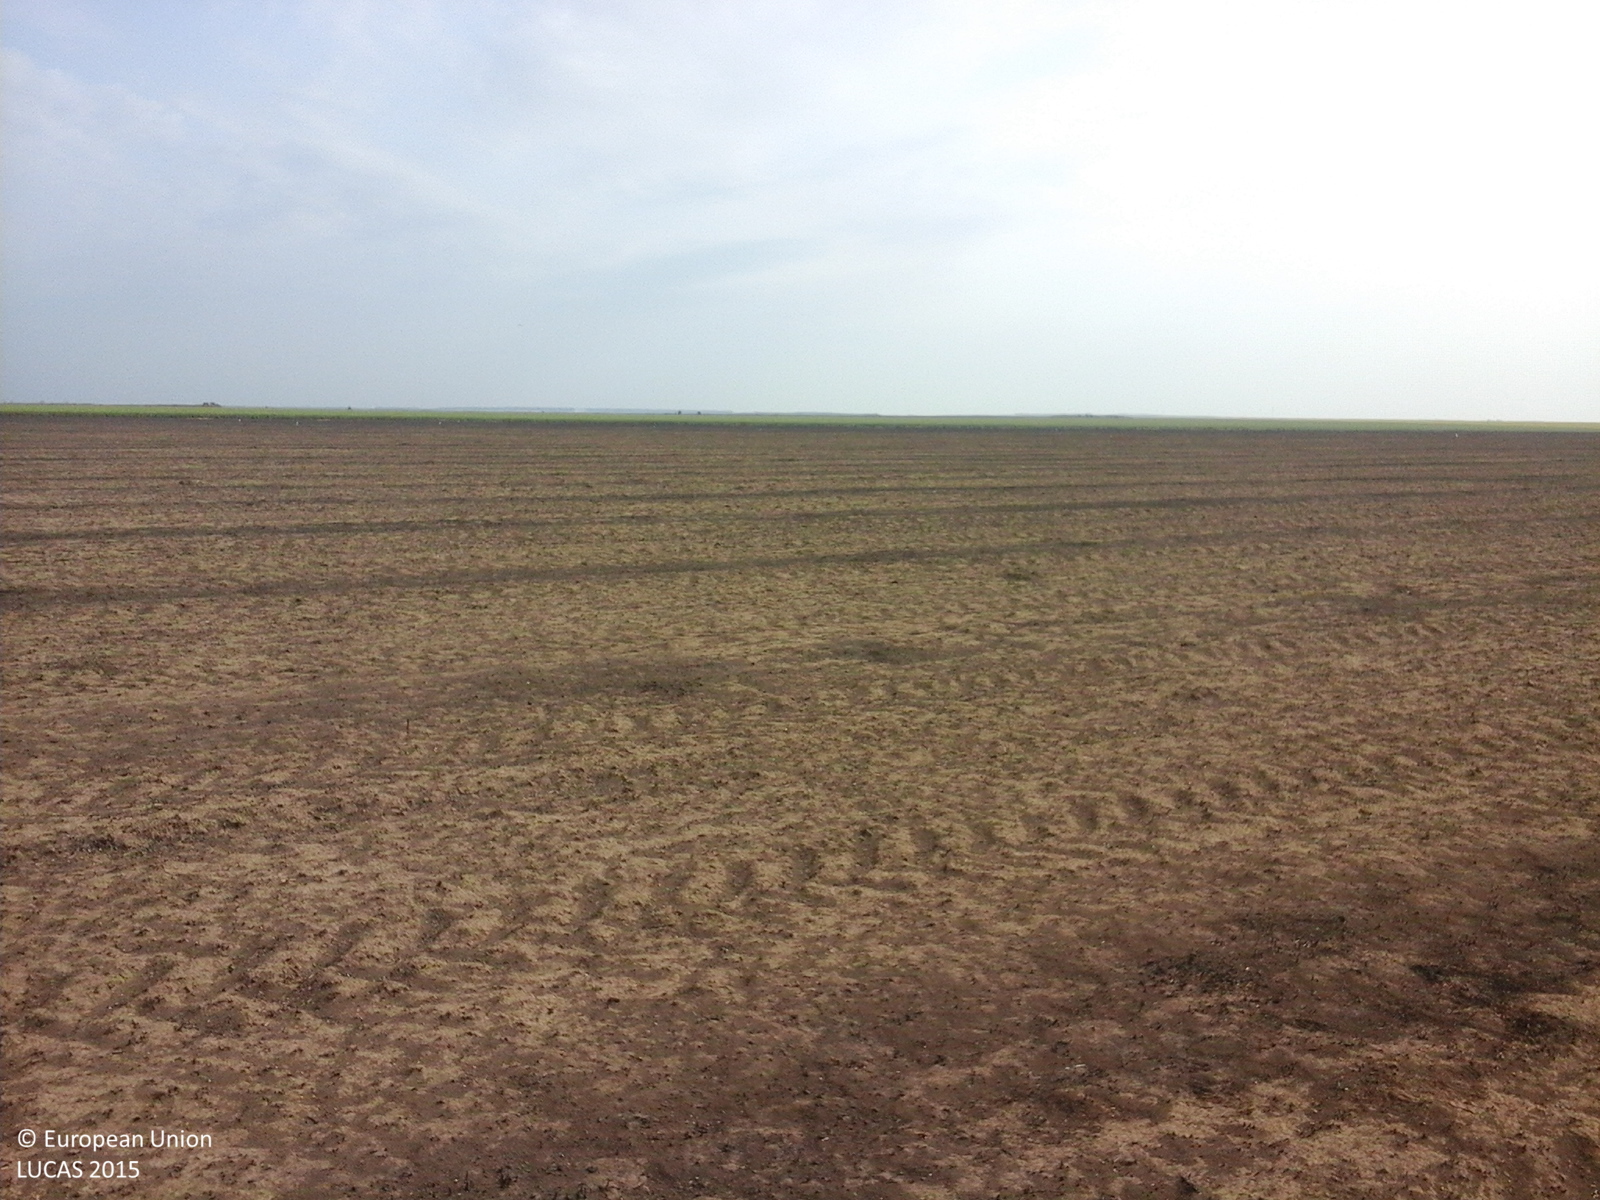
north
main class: Cropland
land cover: Common wheat
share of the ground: < 10 %
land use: Agriculture (excluding fallow land and kitchen gardens)
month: August
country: RO
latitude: 43.8488
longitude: 28.4112
